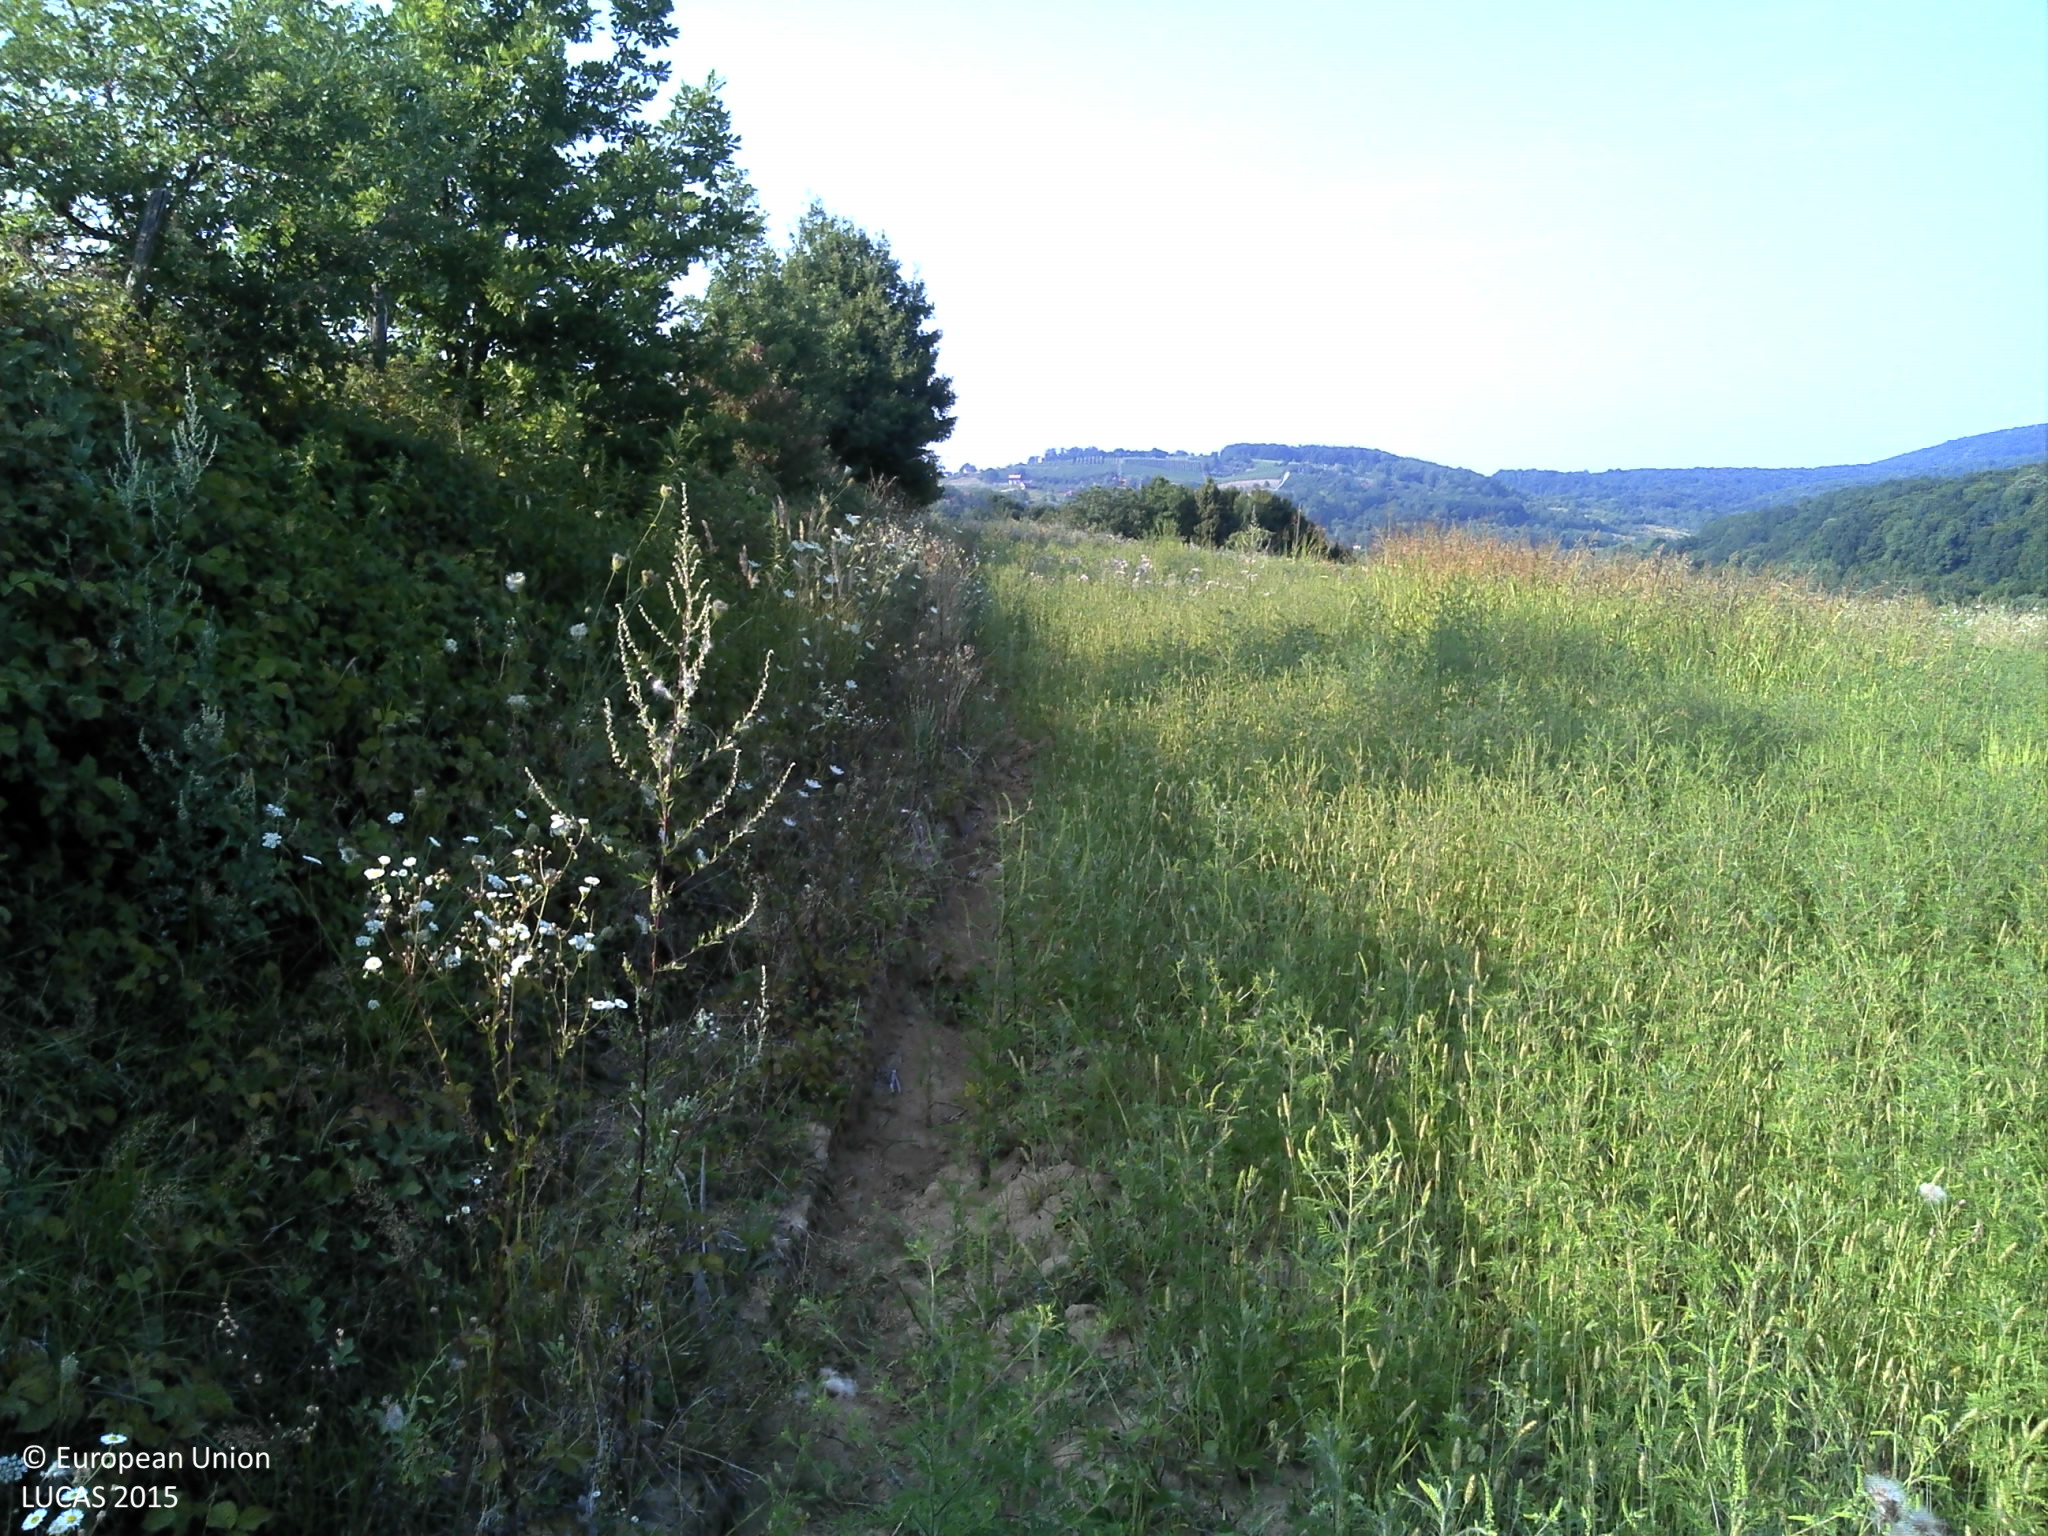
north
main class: Woodland
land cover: Broadleaved woodland
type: acidophilous oak and oak-birch forest
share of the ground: > 75 %
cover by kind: broadleaved forest trees 100 %
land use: Forestry
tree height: > 5 m
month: August
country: HR
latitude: 45.5811
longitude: 17.2419
